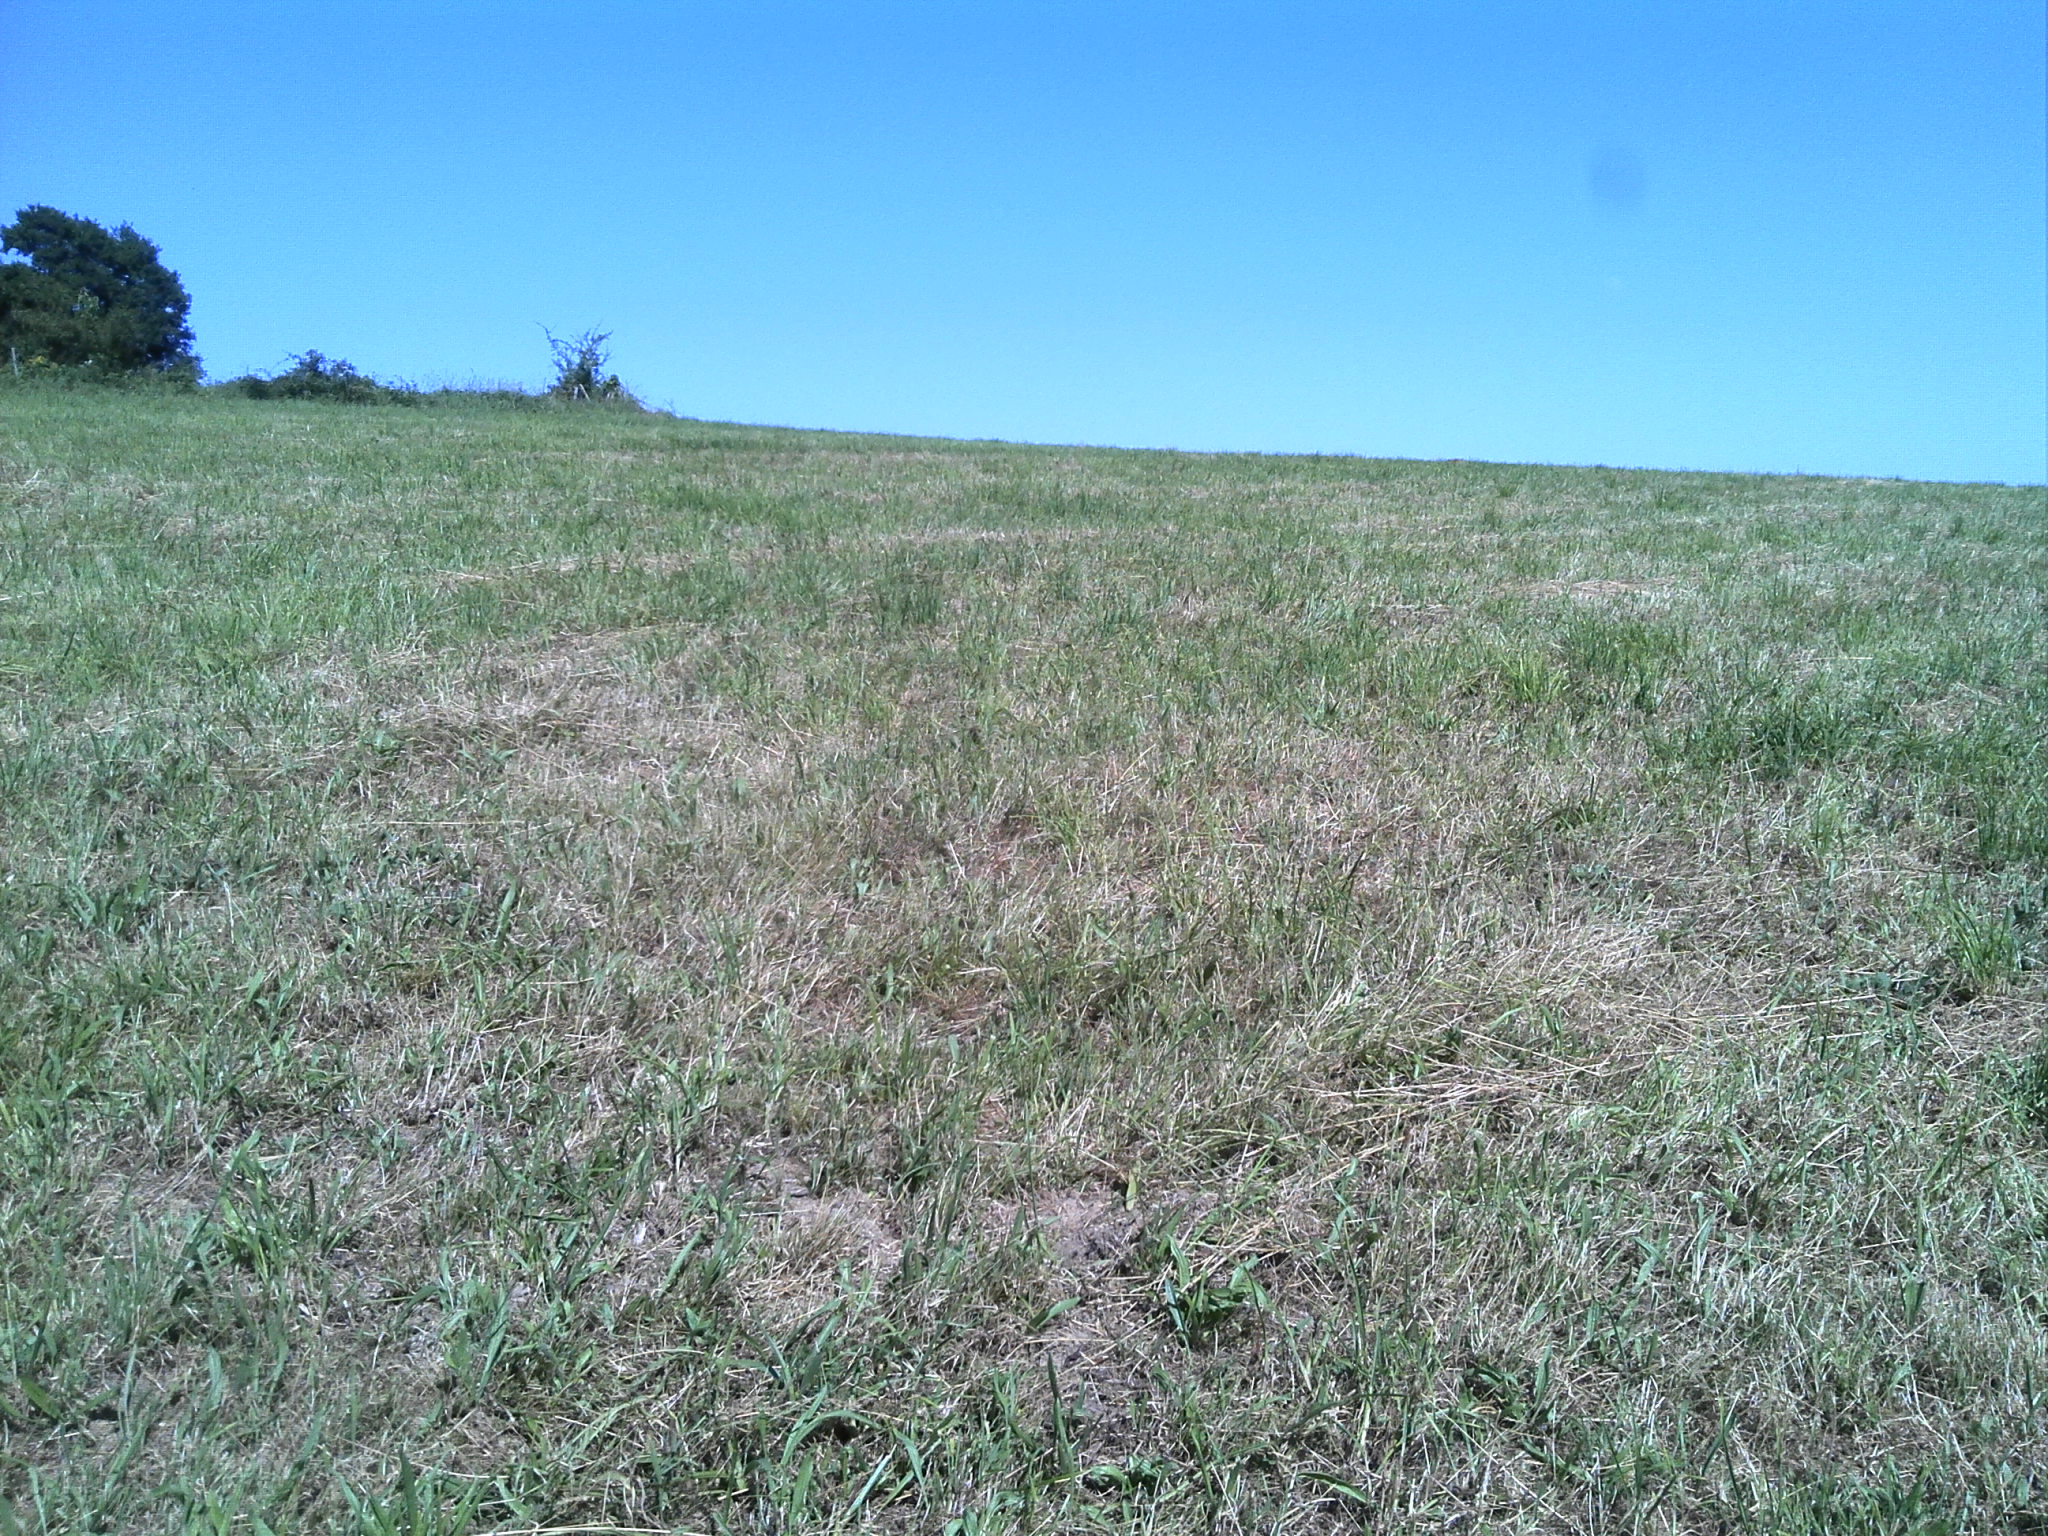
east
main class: Grassland
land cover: Grassland without tree/shrub cover
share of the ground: > 75 %
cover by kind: herbaceous plants 100 %
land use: Agriculture (excluding fallow land and kitchen gardens)
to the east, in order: Grassland without tree/shrub cover; Fences; Temporary grasslands; Fences; Grassland without tree/shrub cover
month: June
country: FR
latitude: 46.4303
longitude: 1.5182
